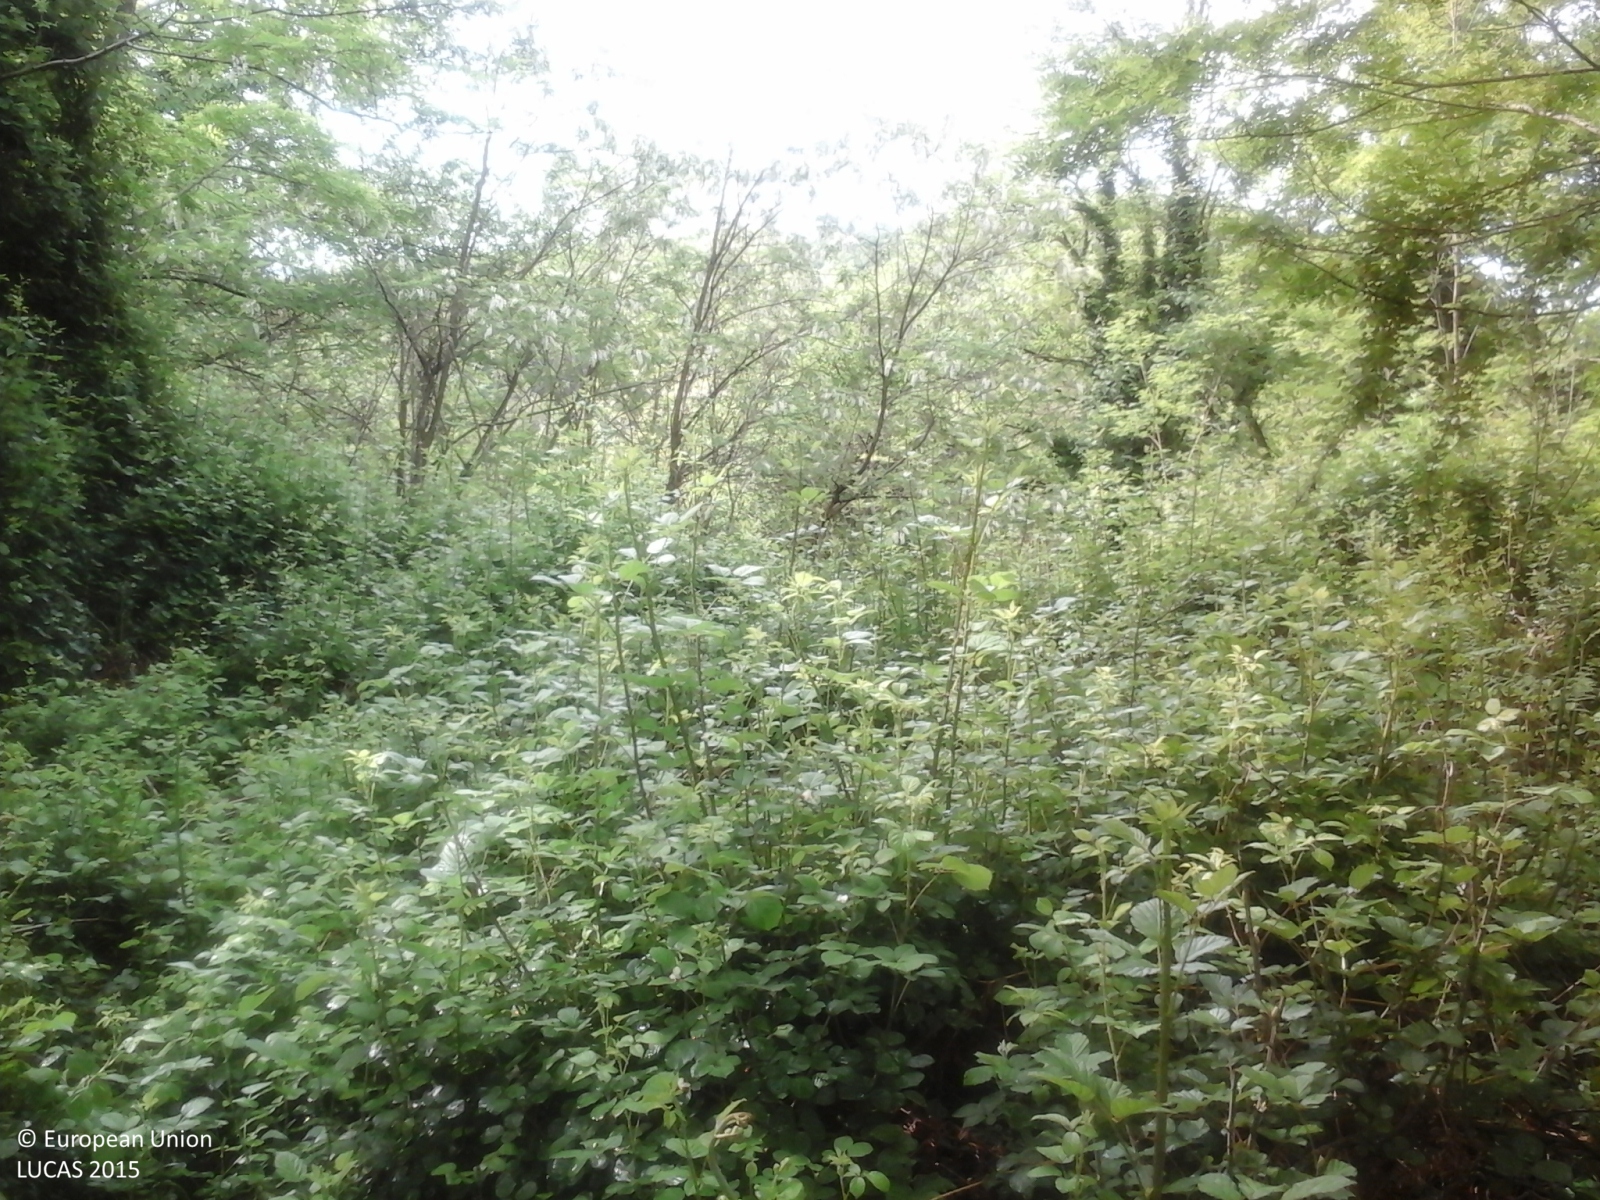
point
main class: Woodland
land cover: Broadleaved woodland
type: thermophilous deciduous forest
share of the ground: > 75 %
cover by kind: broadleaved forest trees 100 %
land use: Forestry
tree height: > 5 m
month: May
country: IT
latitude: 45.7457
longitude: 8.4728
